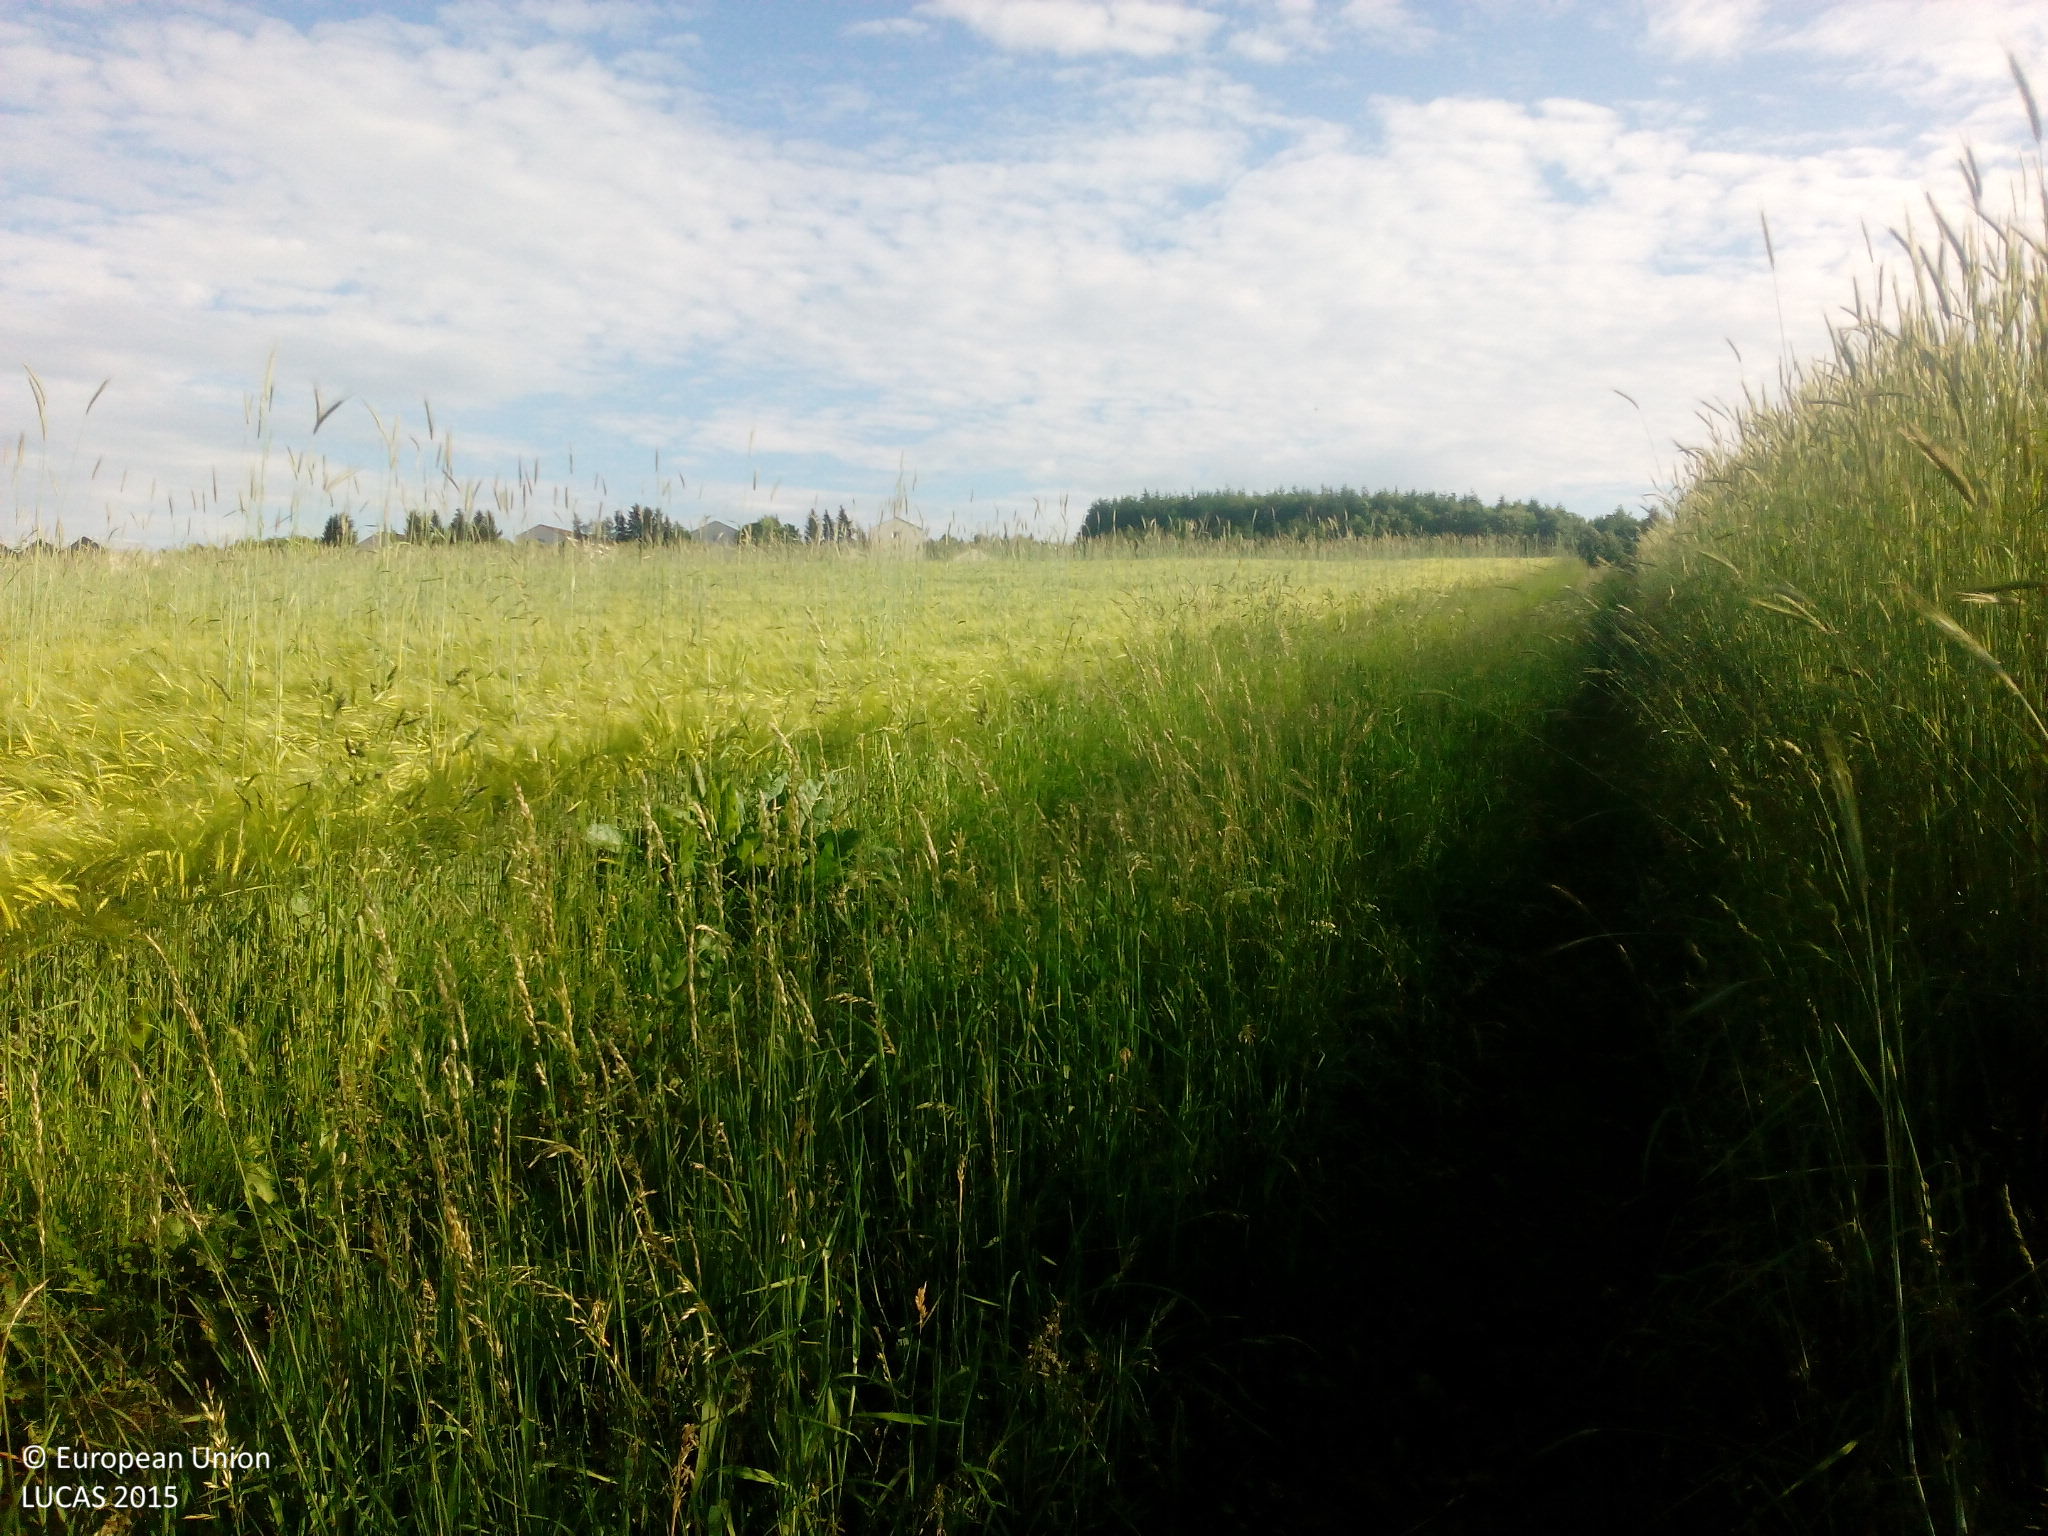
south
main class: Cropland
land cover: Rye
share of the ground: > 75 %
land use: Agriculture (excluding fallow land and kitchen gardens)
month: June
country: DE
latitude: 49.3503
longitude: 12.3535
